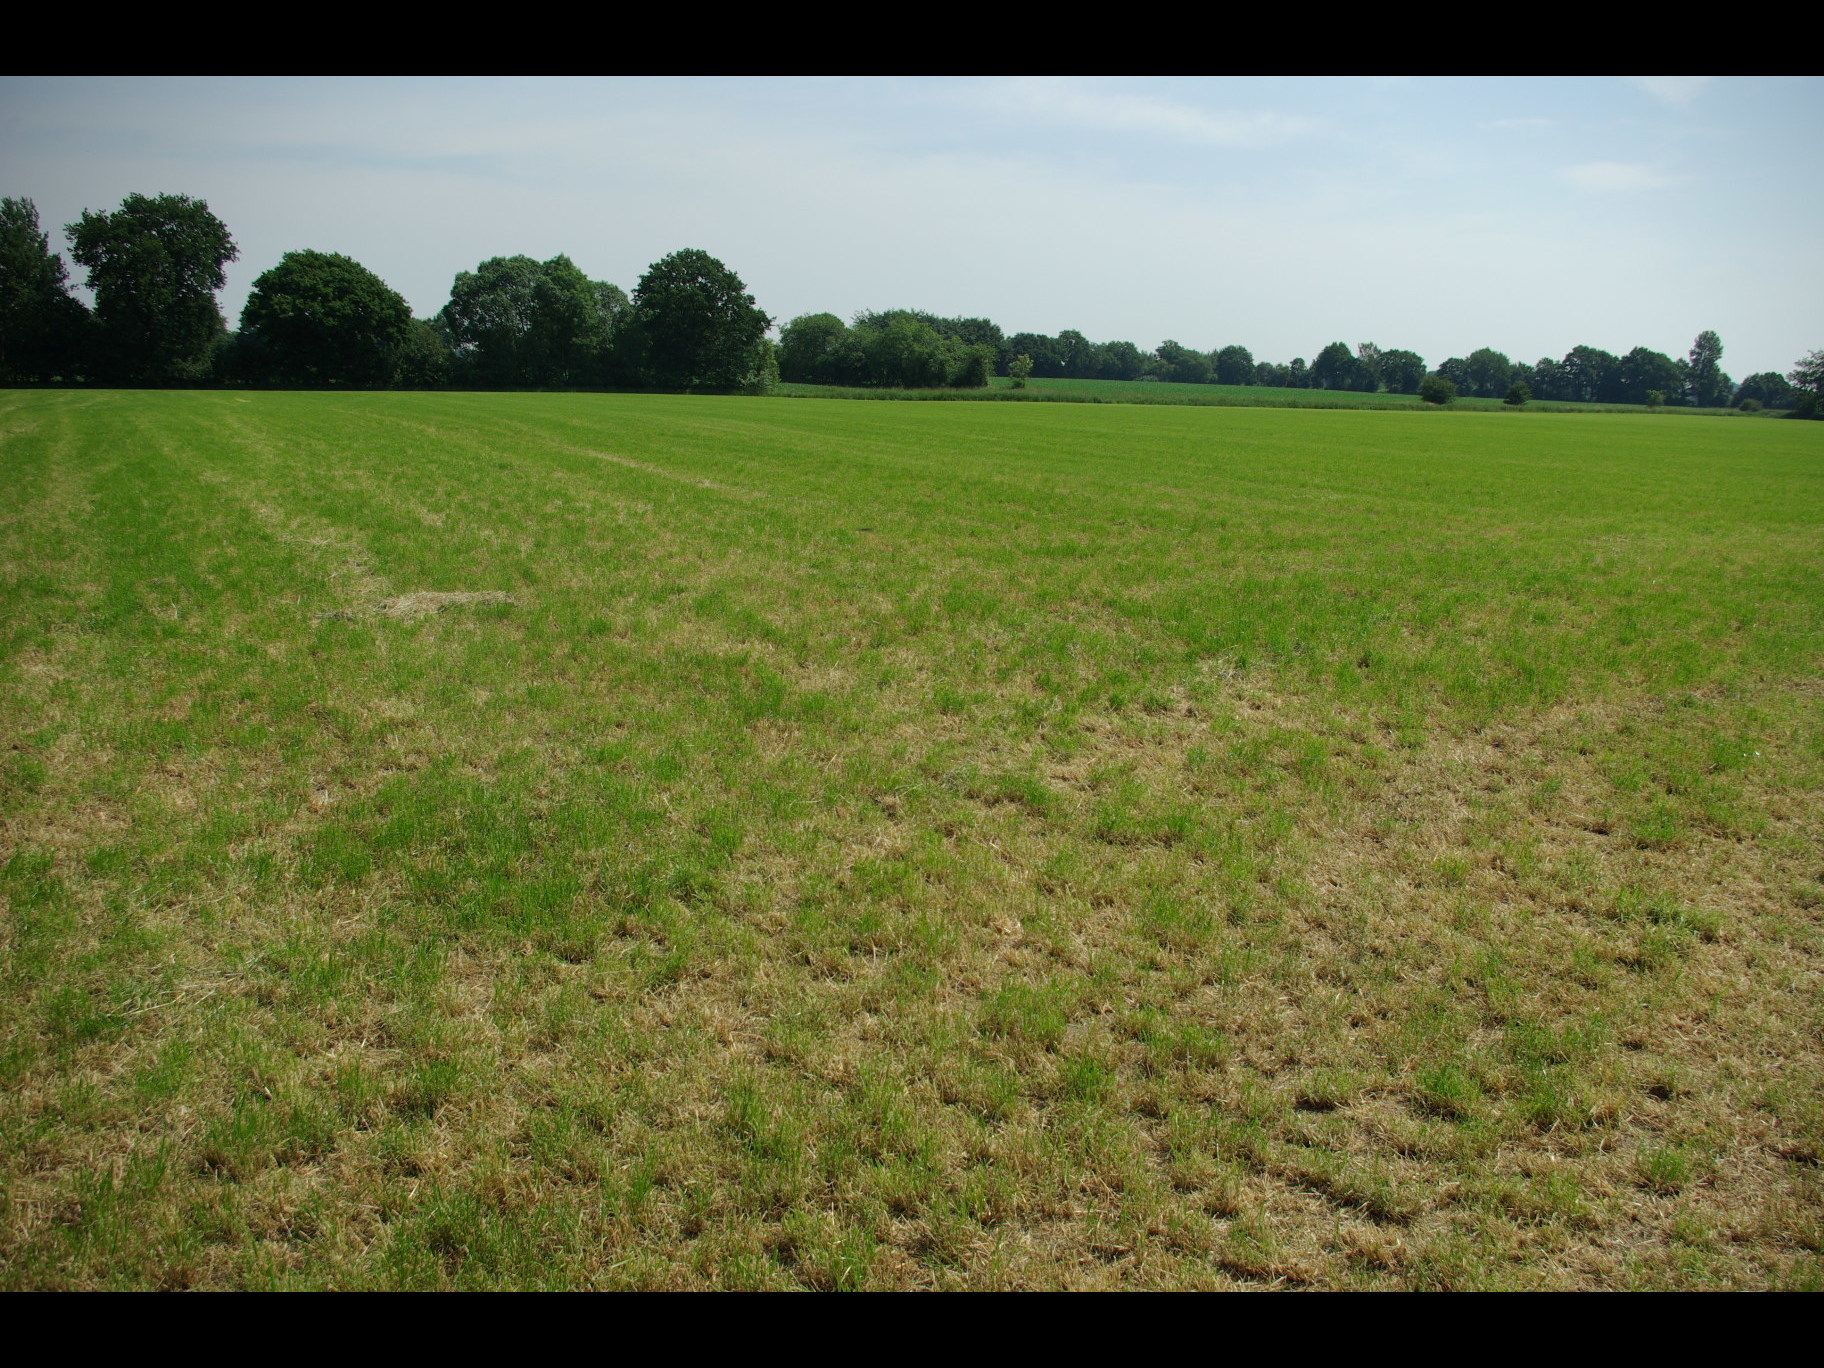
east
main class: Grassland
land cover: Grassland without tree/shrub cover
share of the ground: > 75 %
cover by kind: herbaceous plants 100 %
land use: Agriculture (excluding fallow land and kitchen gardens)
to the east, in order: Grassland without tree/shrub cover; Shruby margins; Fences; Spontaneously vegetated surfaces; Ditches and canals; Spontaneously vegetated surfaces; Maize; Broadleaved woodland; Maize
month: July
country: DE
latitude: 54.2641
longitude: 9.6471
